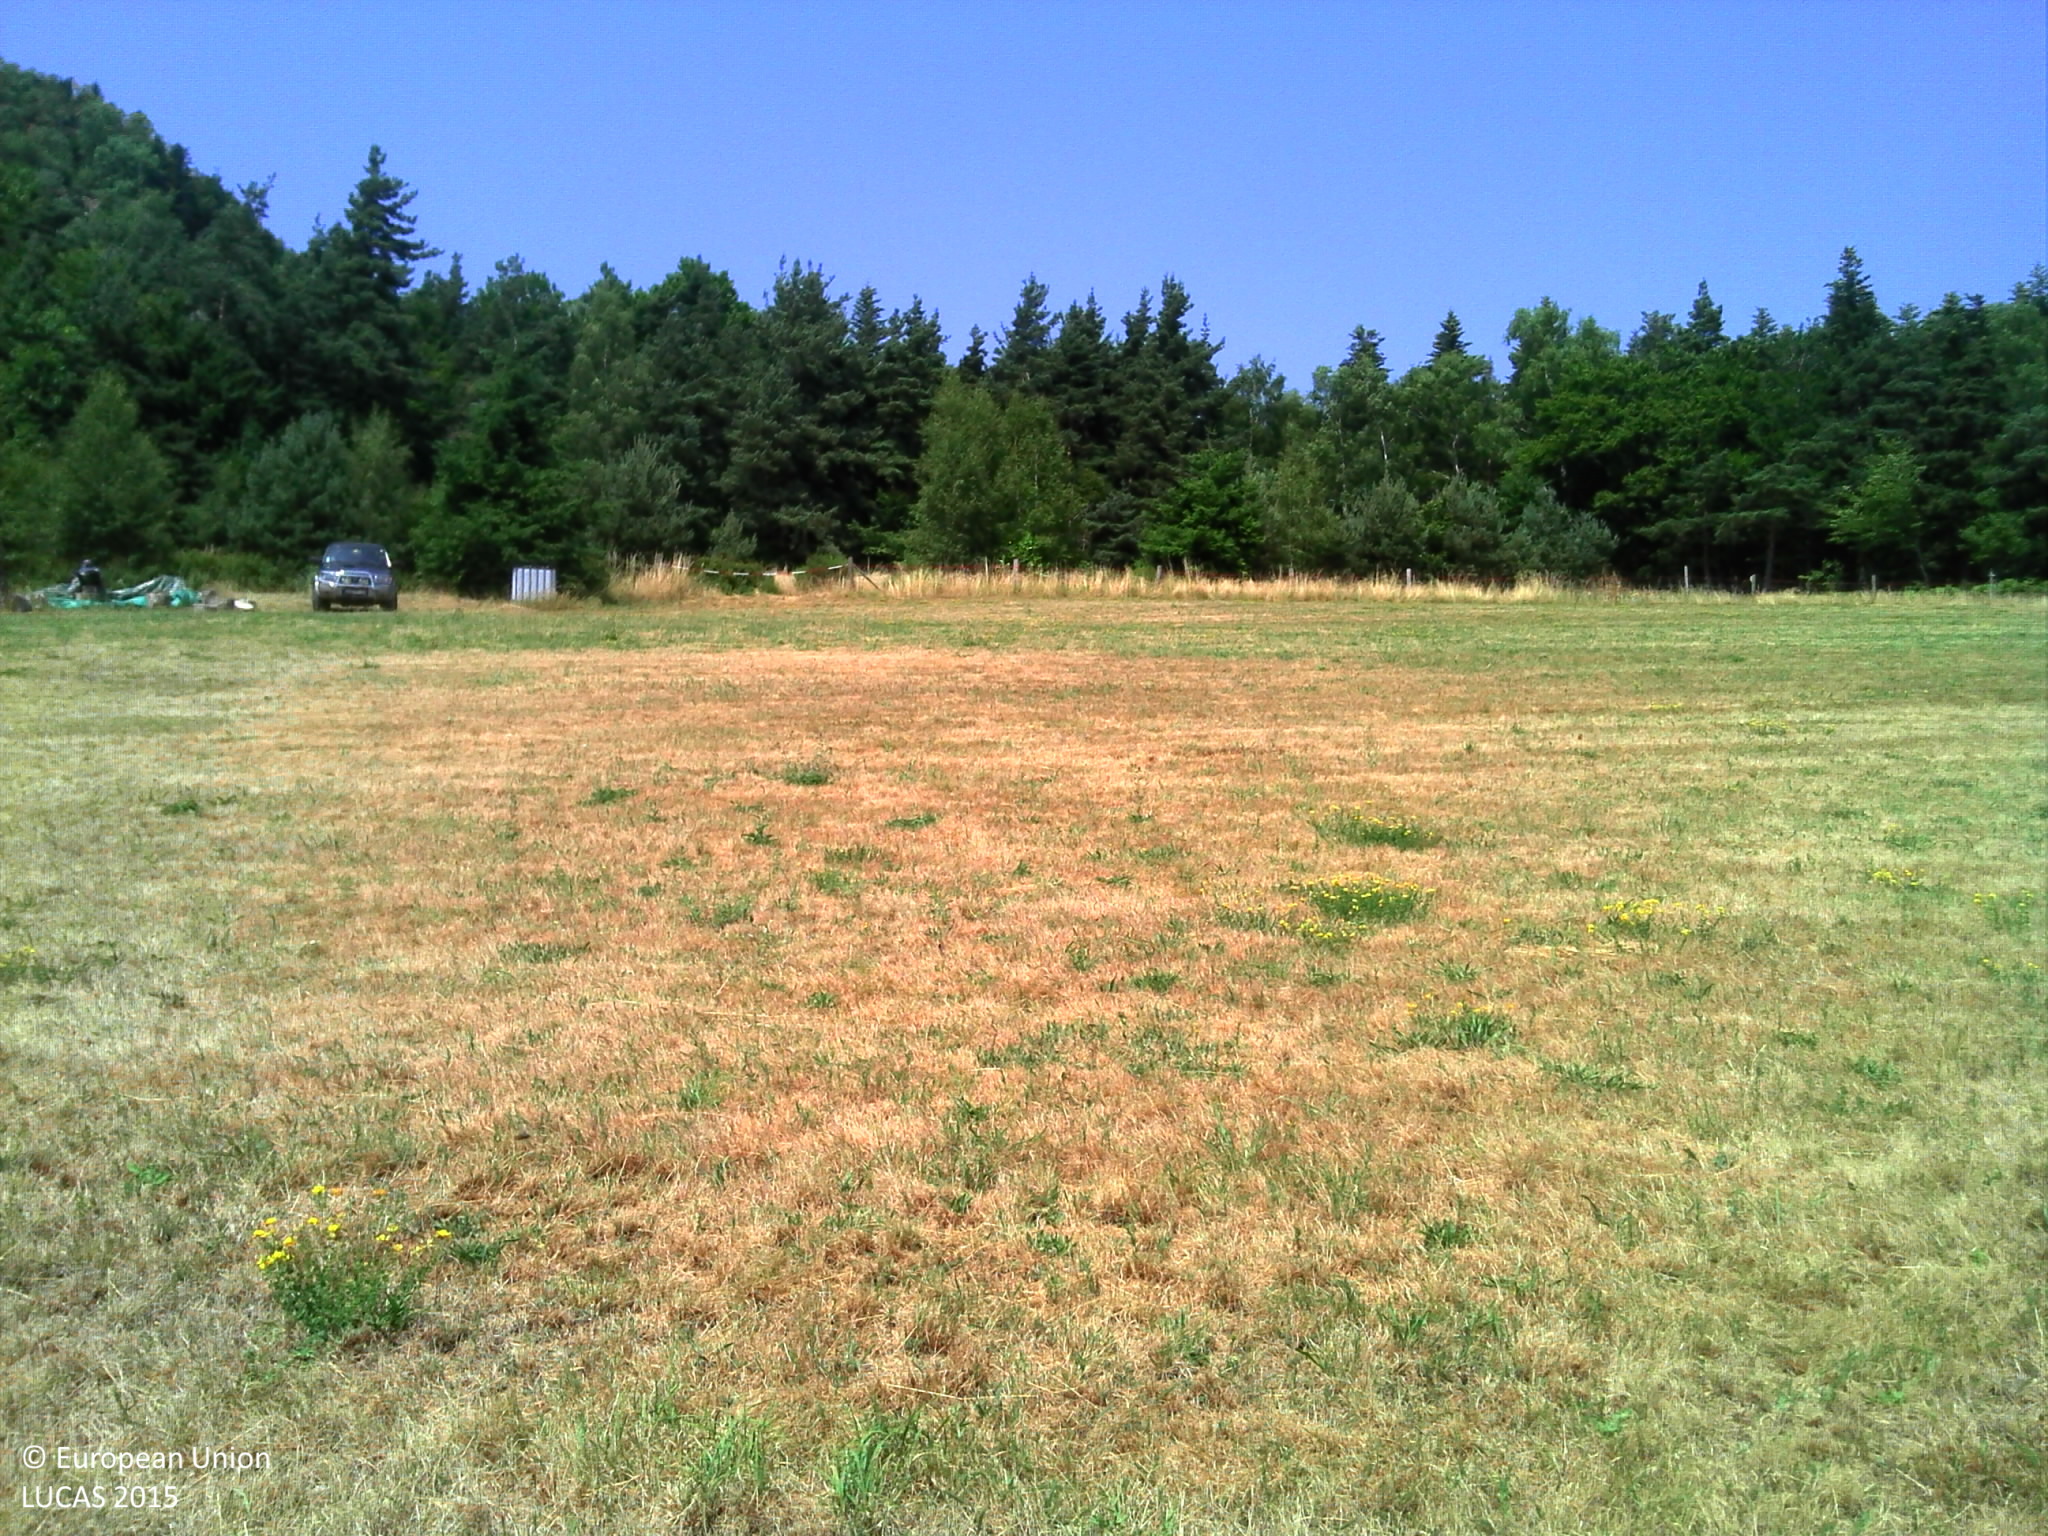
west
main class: Grassland
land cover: Grassland without tree/shrub cover
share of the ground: > 75 %
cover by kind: herbaceous plants 100 %
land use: Agriculture (excluding fallow land and kitchen gardens)
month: July
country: FR
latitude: 45.1085
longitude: 4.1706
